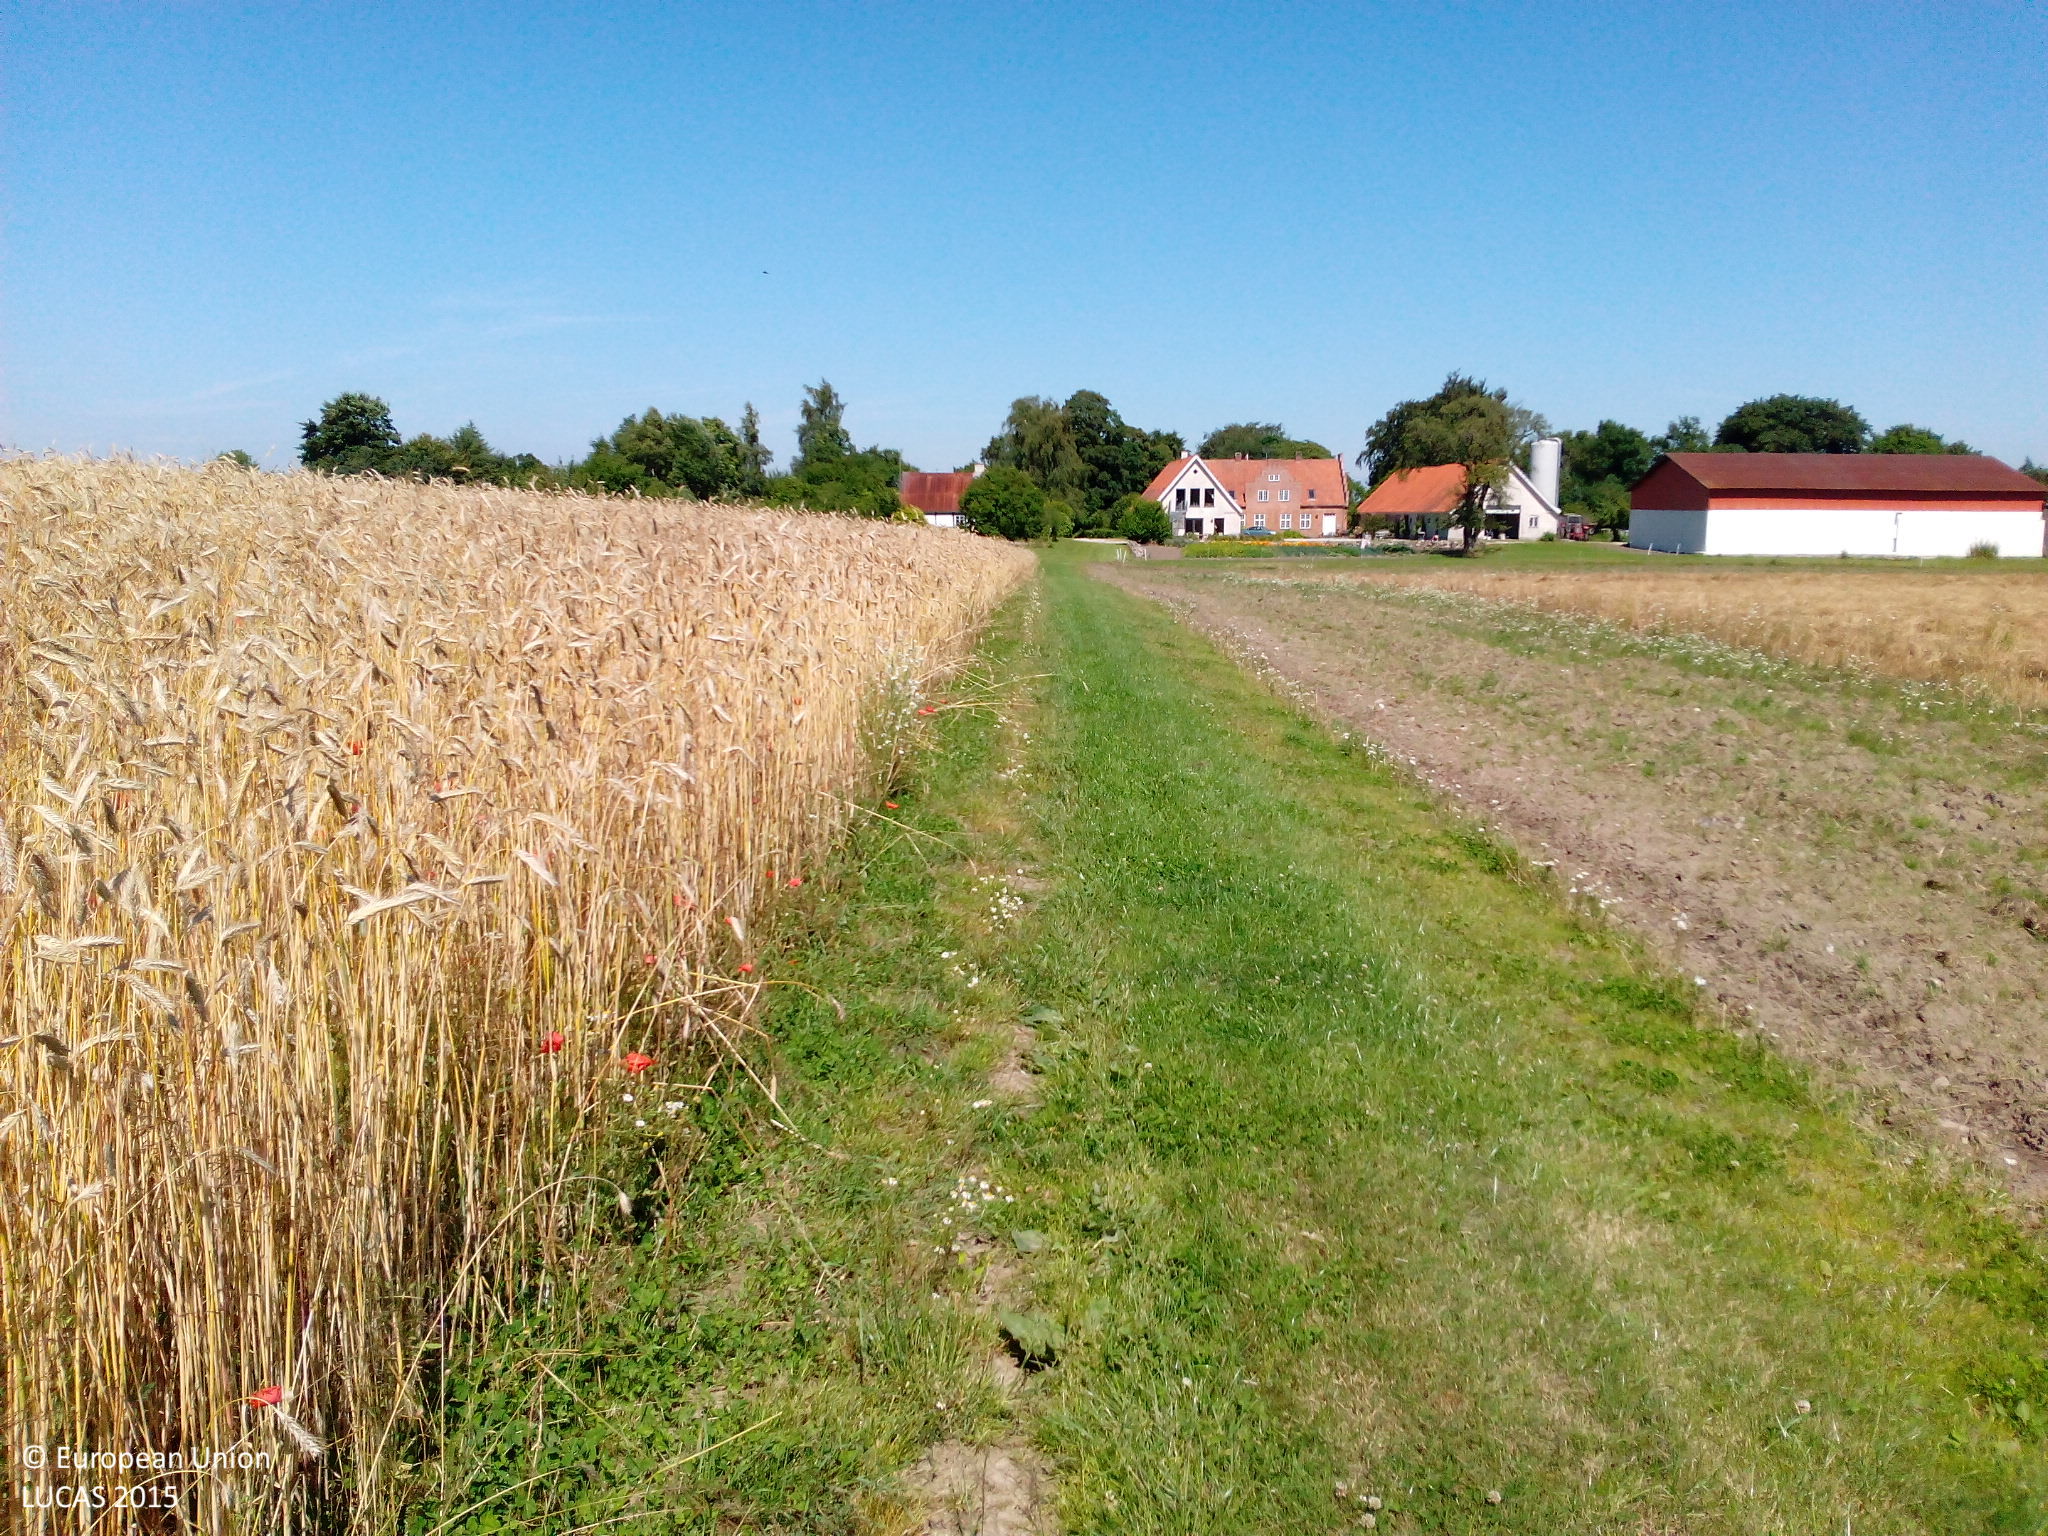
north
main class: Cropland
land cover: Rye
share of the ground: > 75 %
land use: Agriculture (excluding fallow land and kitchen gardens)
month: August
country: DK
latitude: 55.5806
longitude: 11.8861
